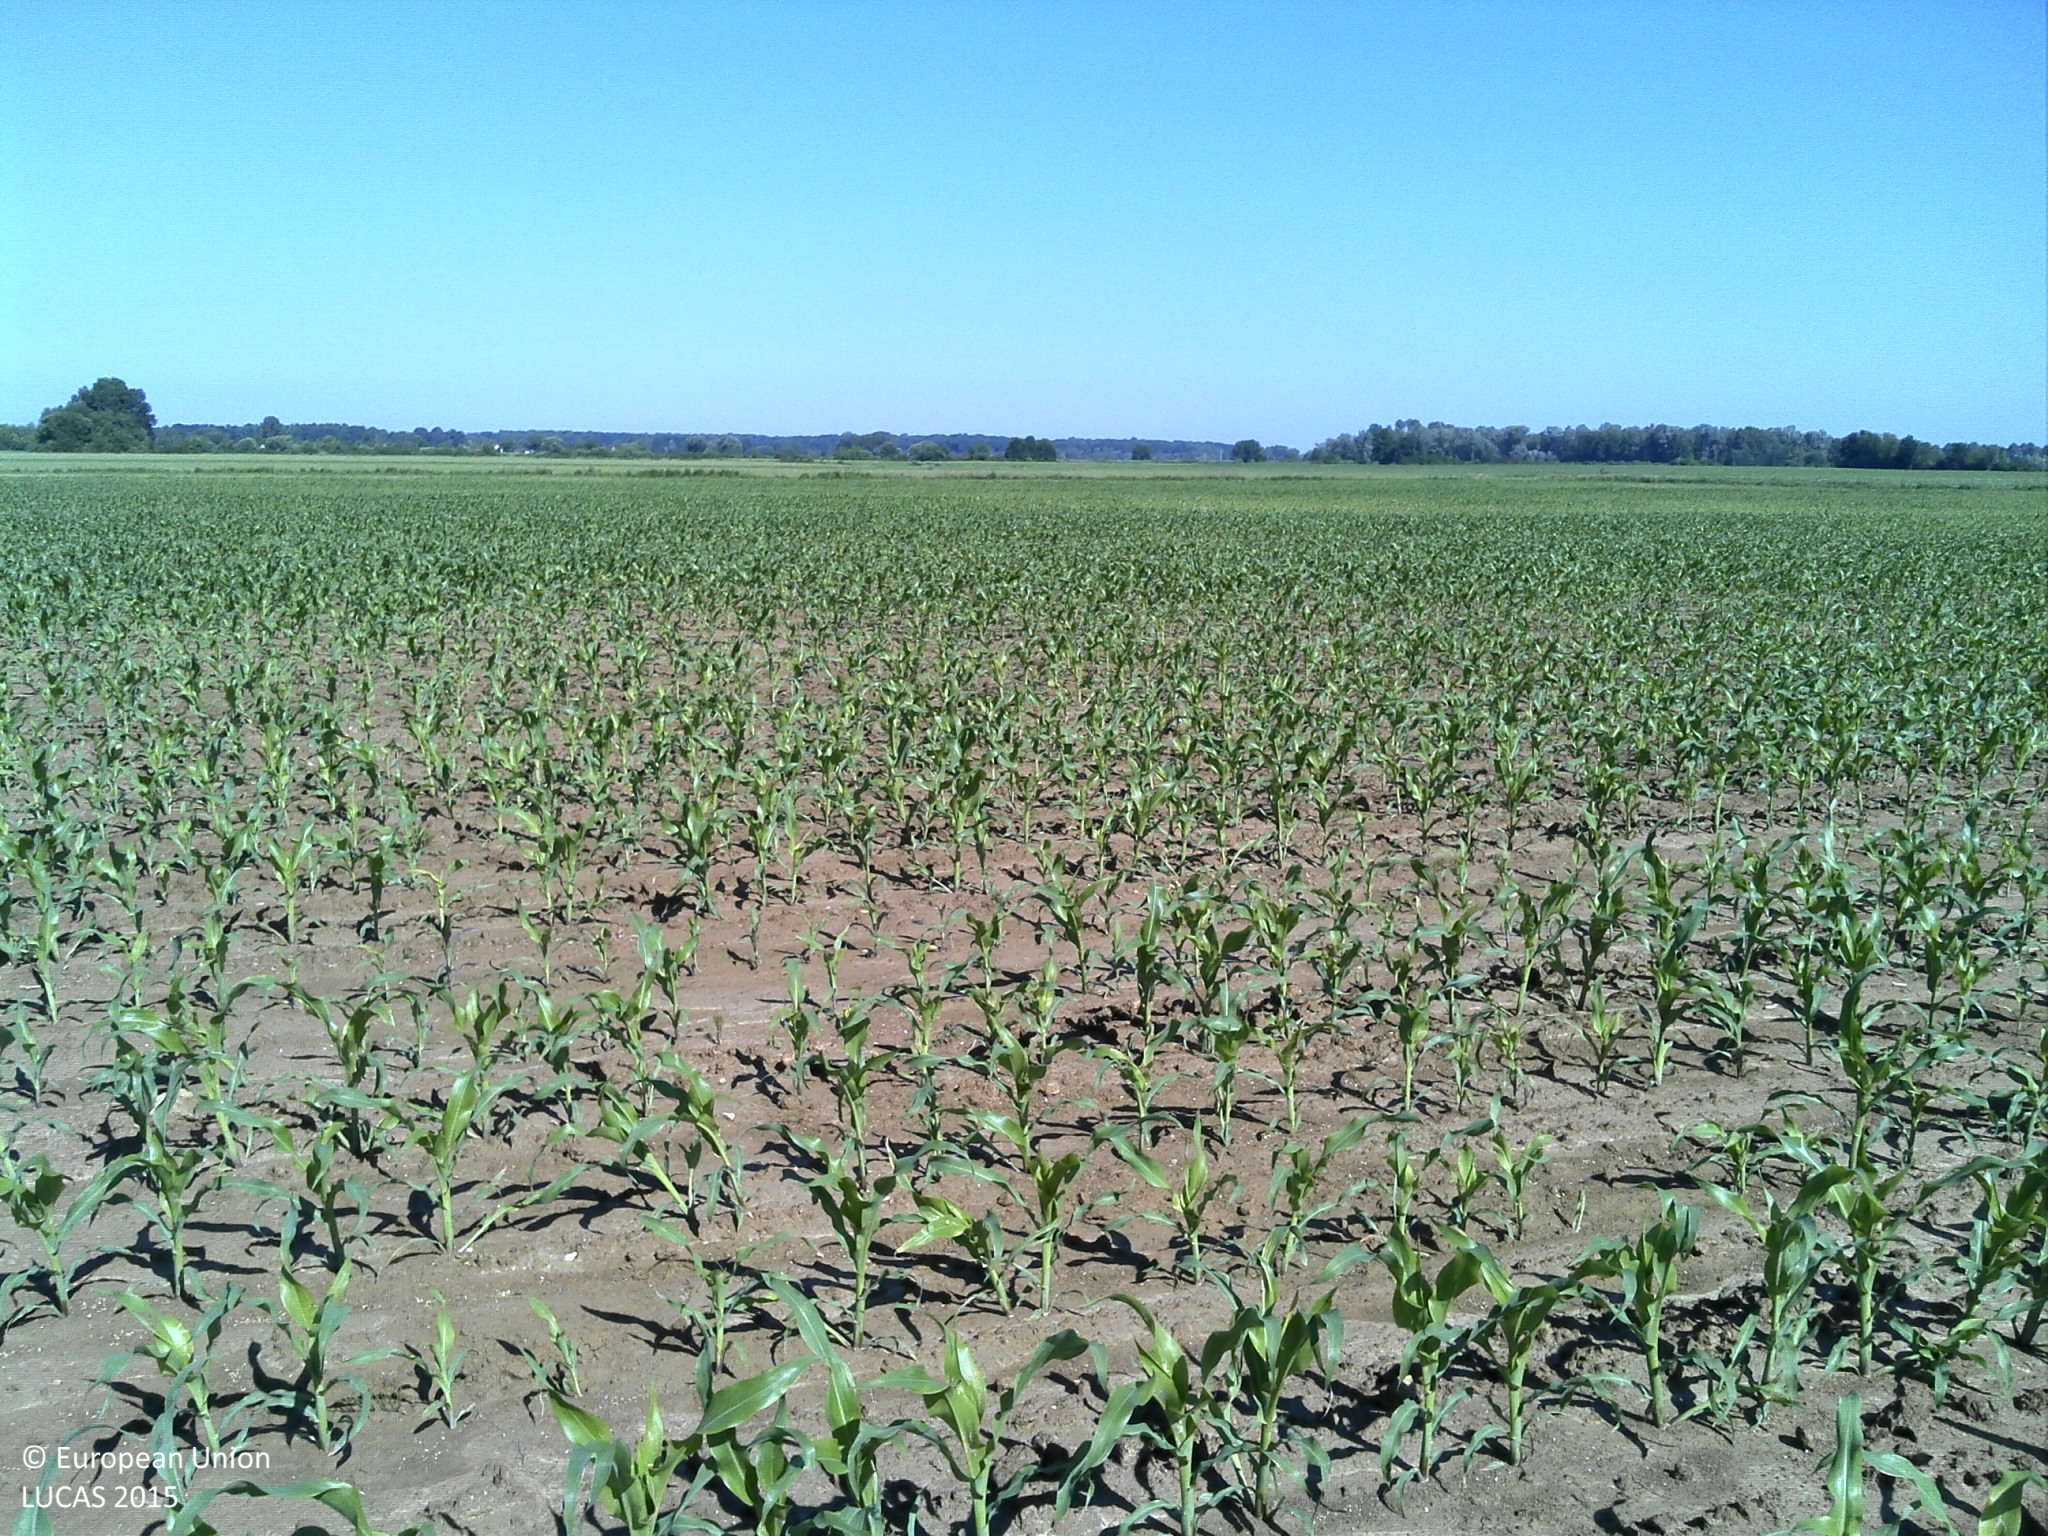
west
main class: Cropland
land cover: Maize
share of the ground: 50 - 75 %
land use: Agriculture (excluding fallow land and kitchen gardens)
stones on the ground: < 10 %
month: May
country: HR
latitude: 45.6014
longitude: 17.9656
